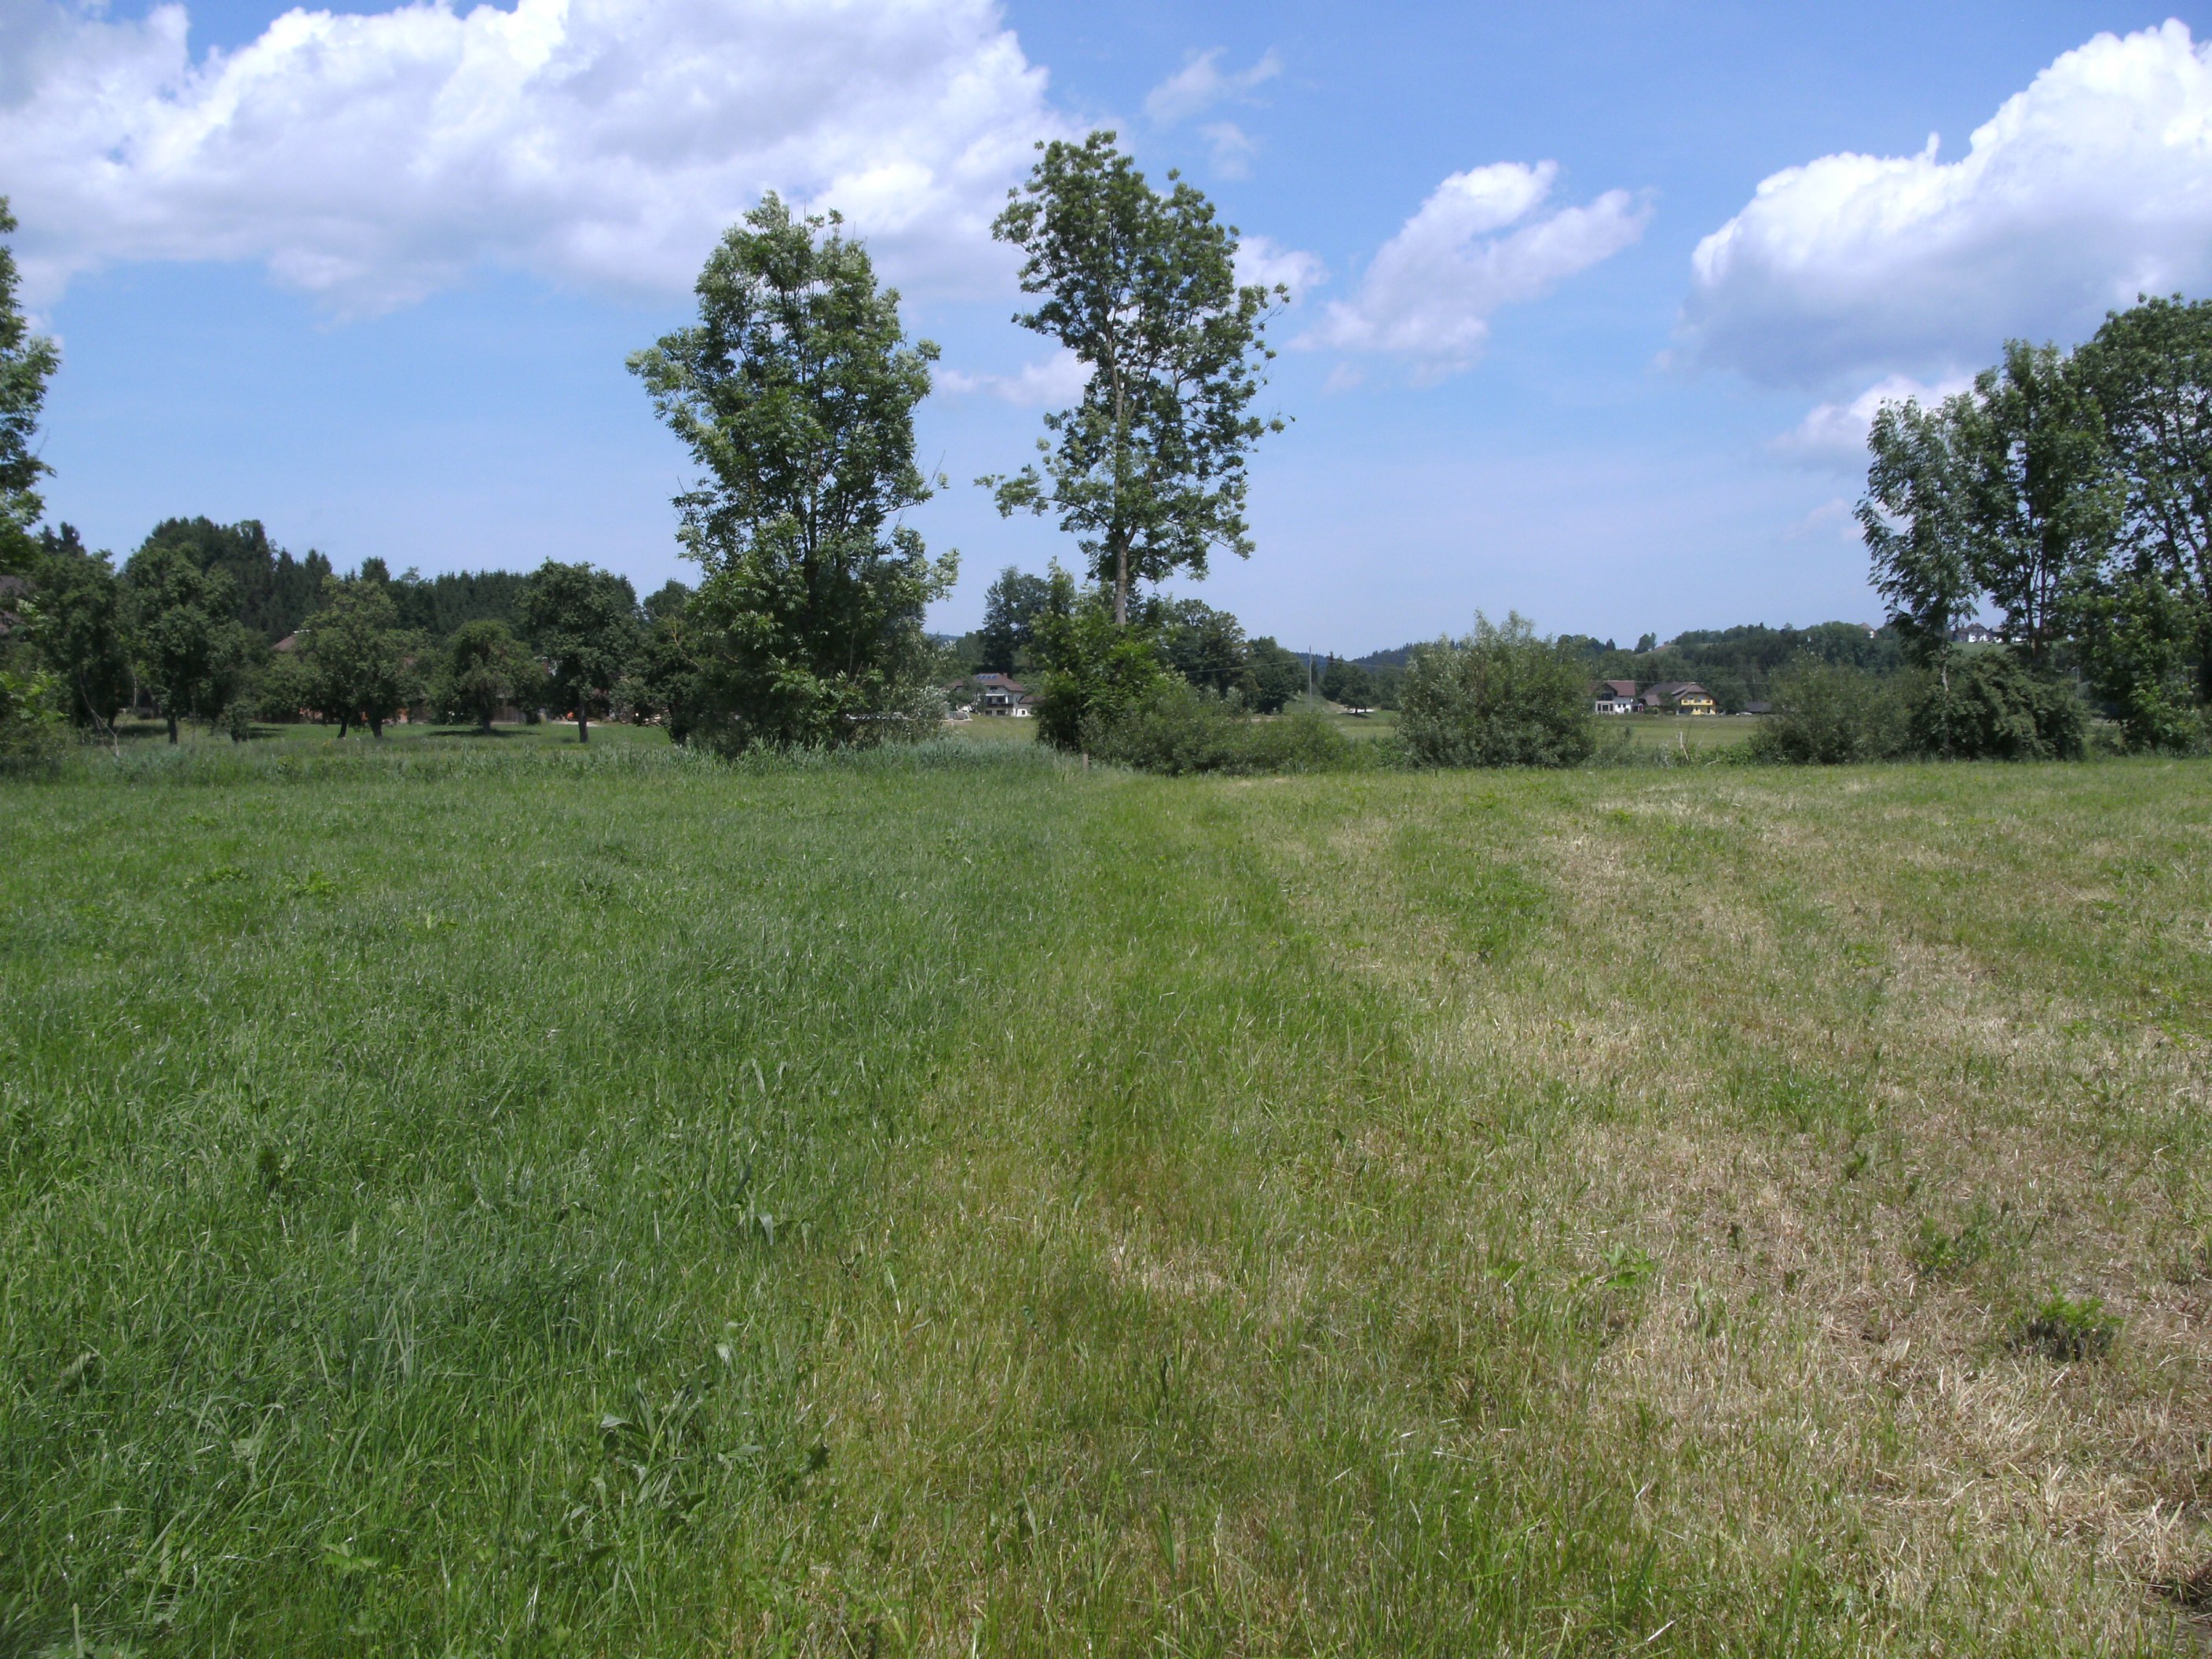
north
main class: Grassland
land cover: Grassland without tree/shrub cover
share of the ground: > 75 %
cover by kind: herbaceous plants 100 %
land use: Agriculture (excluding fallow land and kitchen gardens)
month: May
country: AT
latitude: 48.0222
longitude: 13.5523
